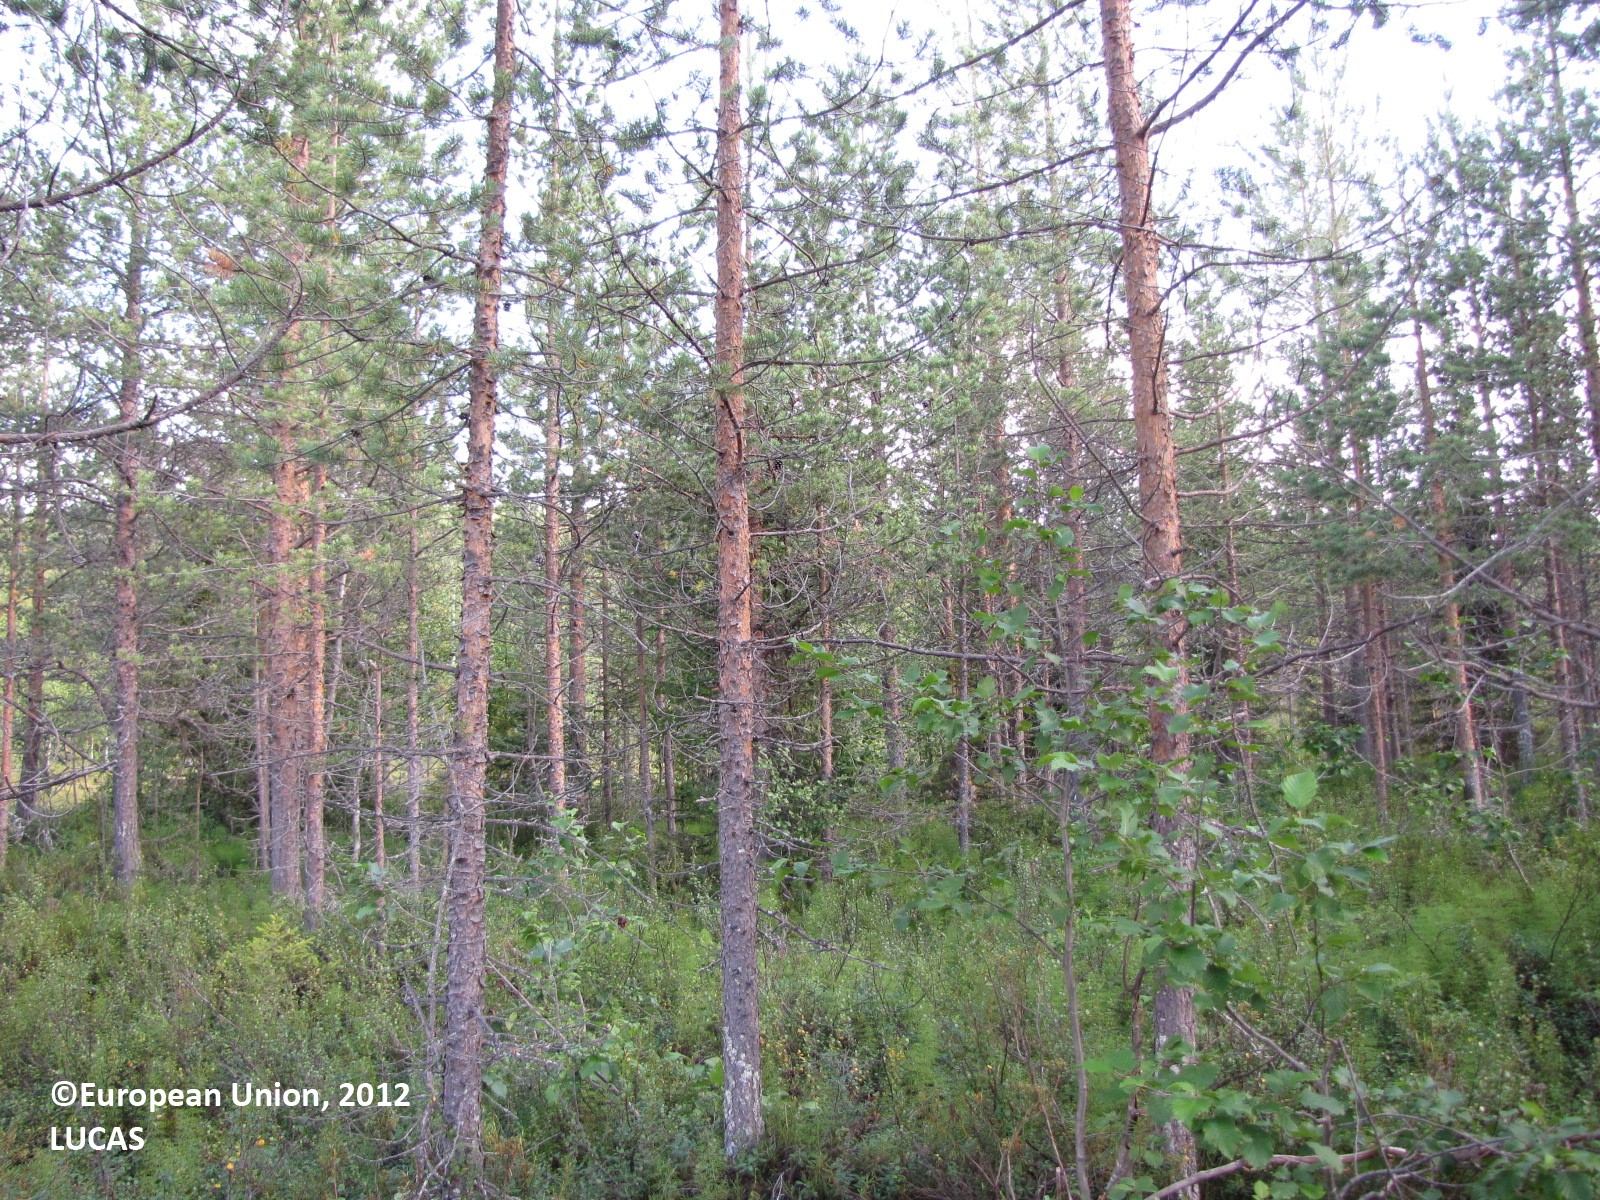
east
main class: Woodland
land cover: Pine dominated coniferous woodland
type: boreal forest
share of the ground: 50 - 75 %
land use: Forestry
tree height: > 5 m
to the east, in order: Pine dominated coniferous woodland; Ditches and canals; Pine dominated coniferous woodland; Rivers and streams; Spruce dominated mixed woodland; Ditches and canals; Spruce dominated mixed woodland; Ditches and canals; Spruce dominated mixed woodland; Ditches and canals; Shruby margins; Paved roads, cycling and walking lanes; Shruby margins; Ditches and canals; Pine dominated mixed woodland
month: August
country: FI
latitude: 66.8490
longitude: 25.1175
